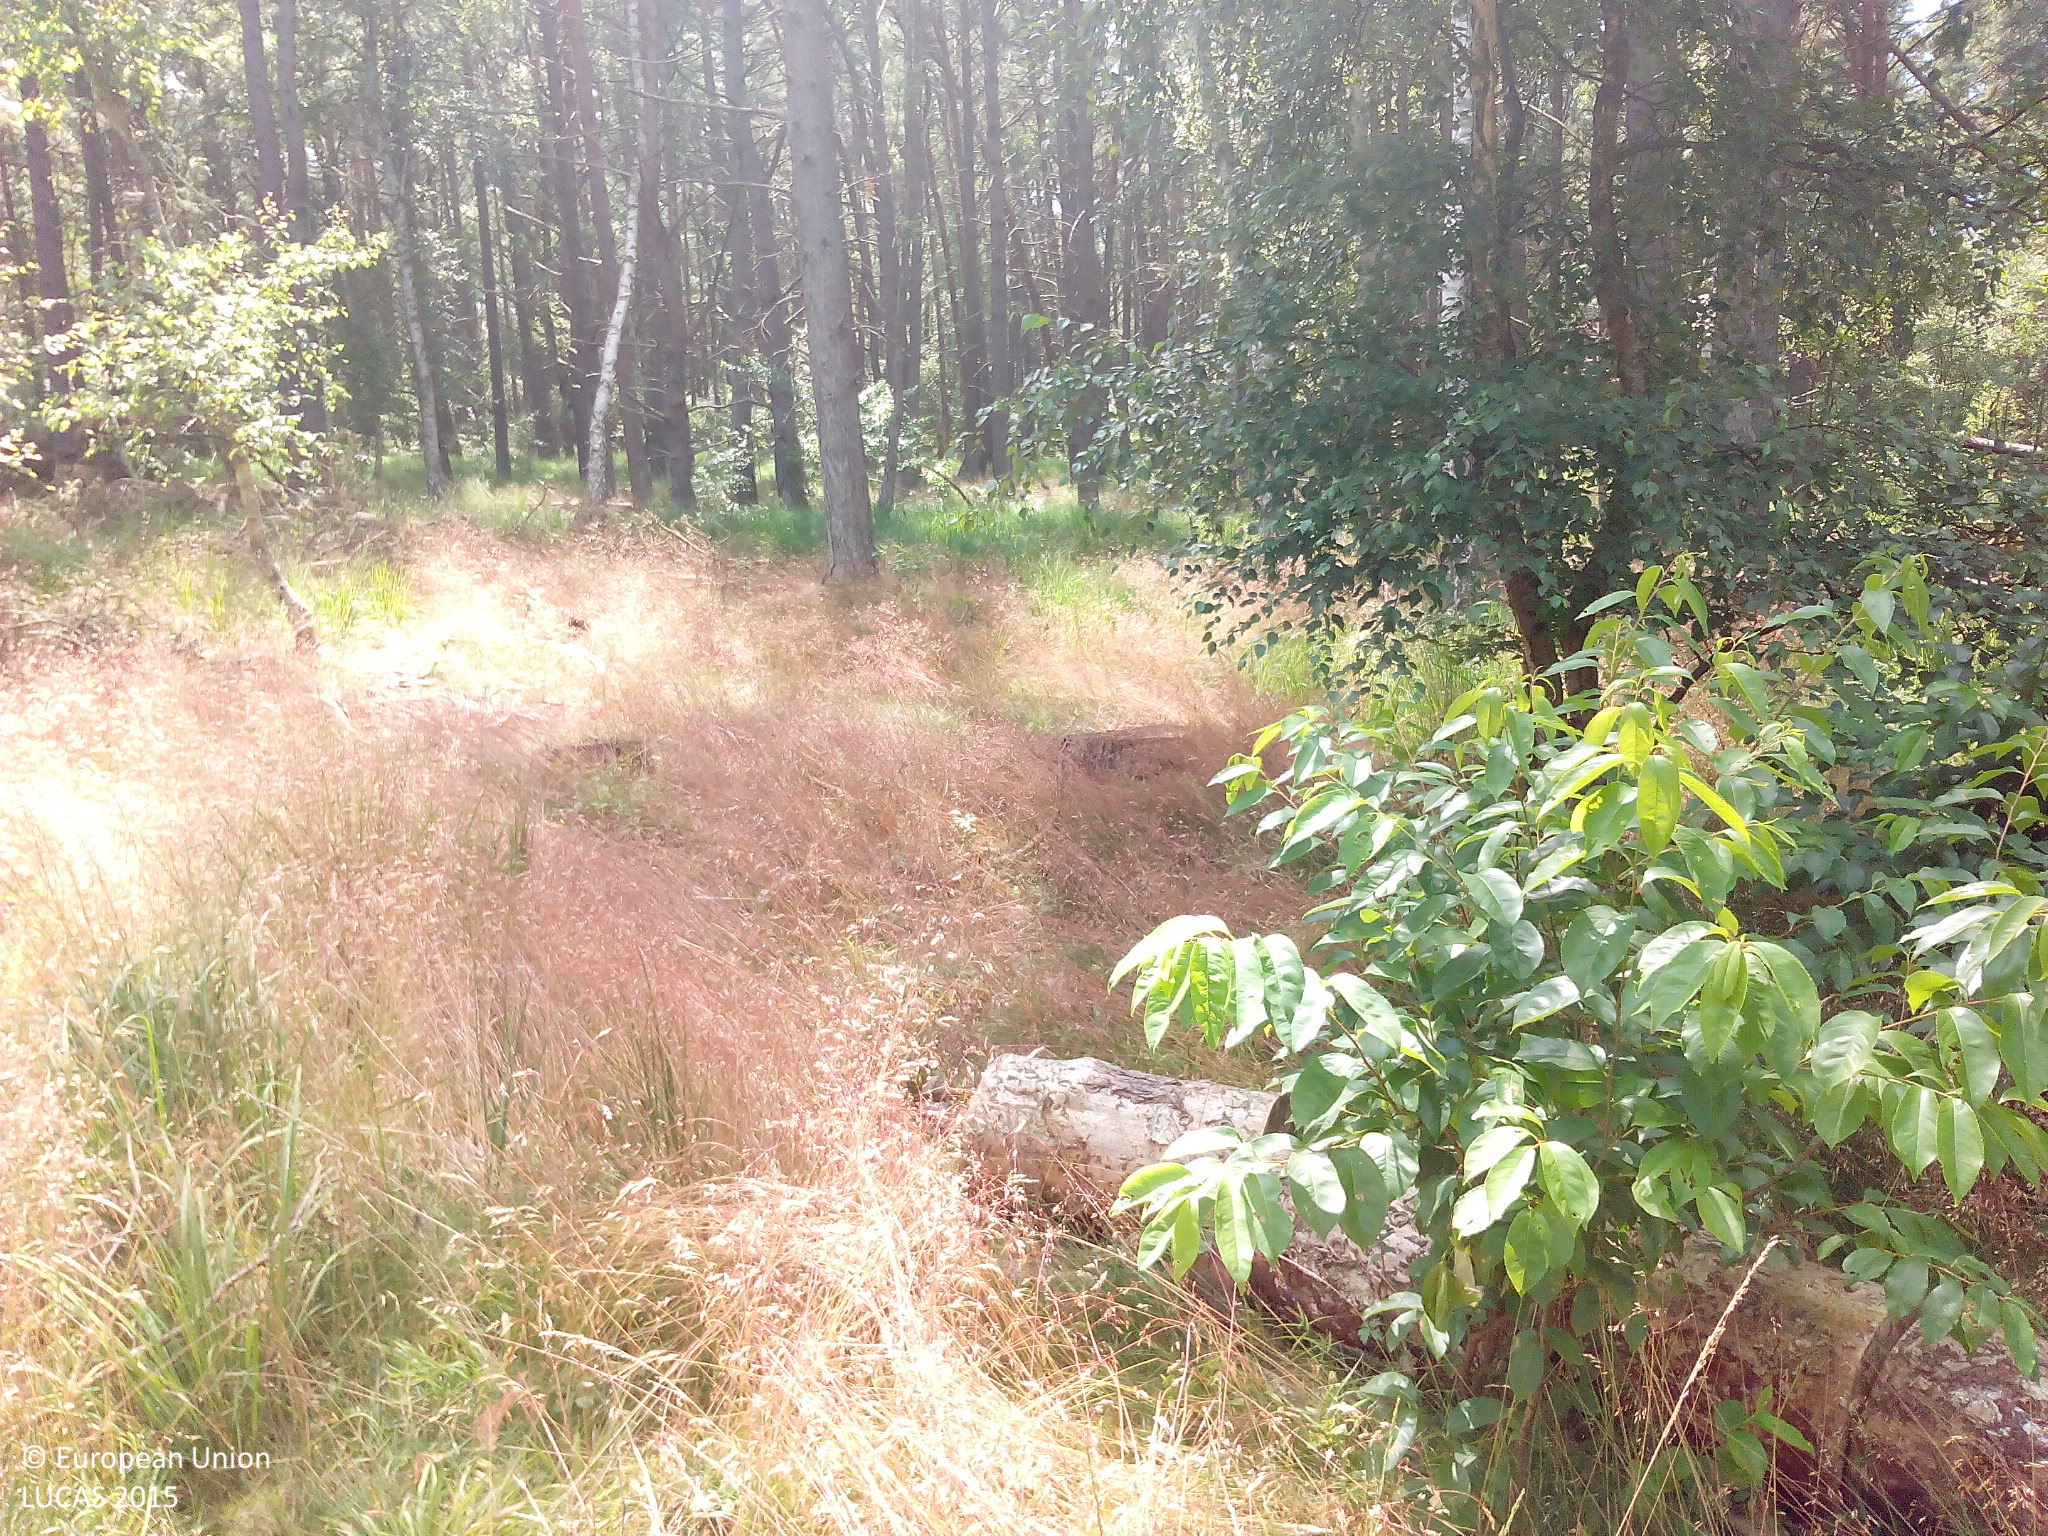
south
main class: Woodland
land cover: Broadleaved woodland
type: mesophytic deciduous forest
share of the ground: 50 - 75 %
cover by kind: broadleaved forest trees 60 %, herbaceous plants 35 %, coniferous forest trees 5 %
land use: Semi-natural and natural areas not in use
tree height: > 5 m
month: July
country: DE
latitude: 54.4336
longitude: 12.6659
